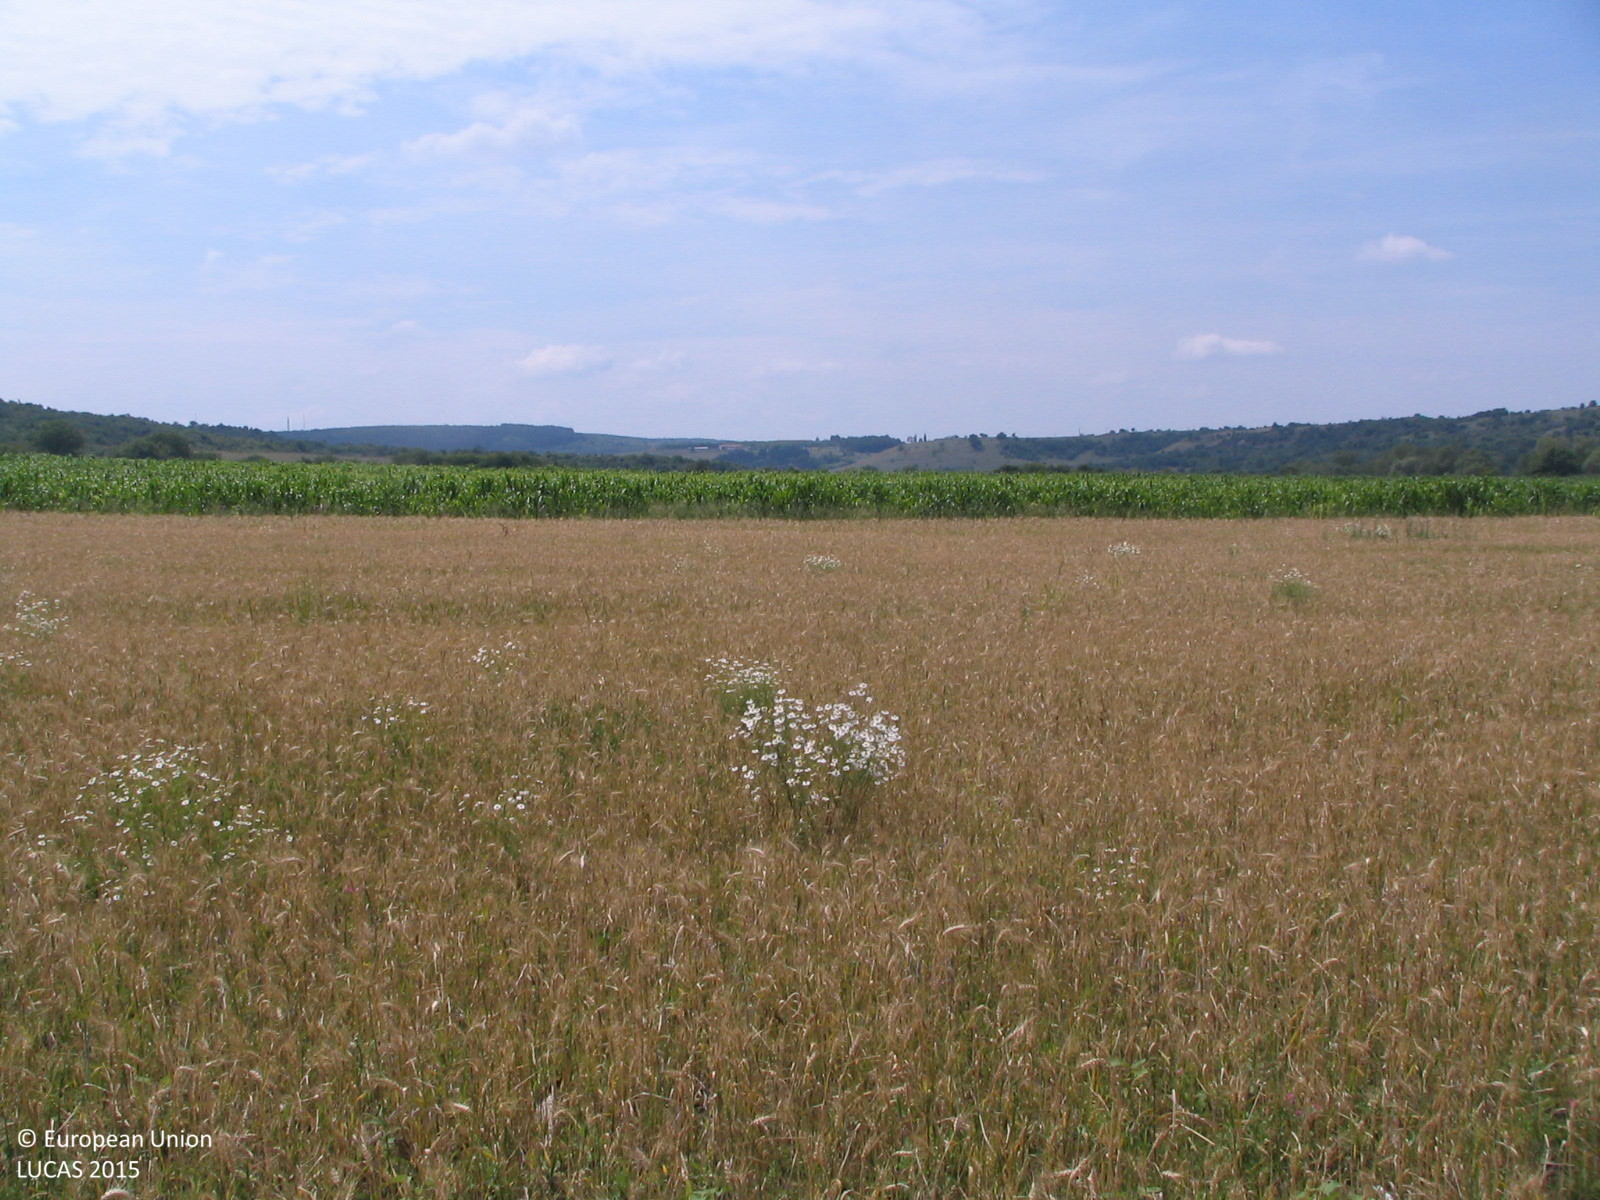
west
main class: Cropland
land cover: Common wheat
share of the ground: > 75 %
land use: Agriculture (excluding fallow land and kitchen gardens)
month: June
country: BG
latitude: 43.3122
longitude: 23.9452
